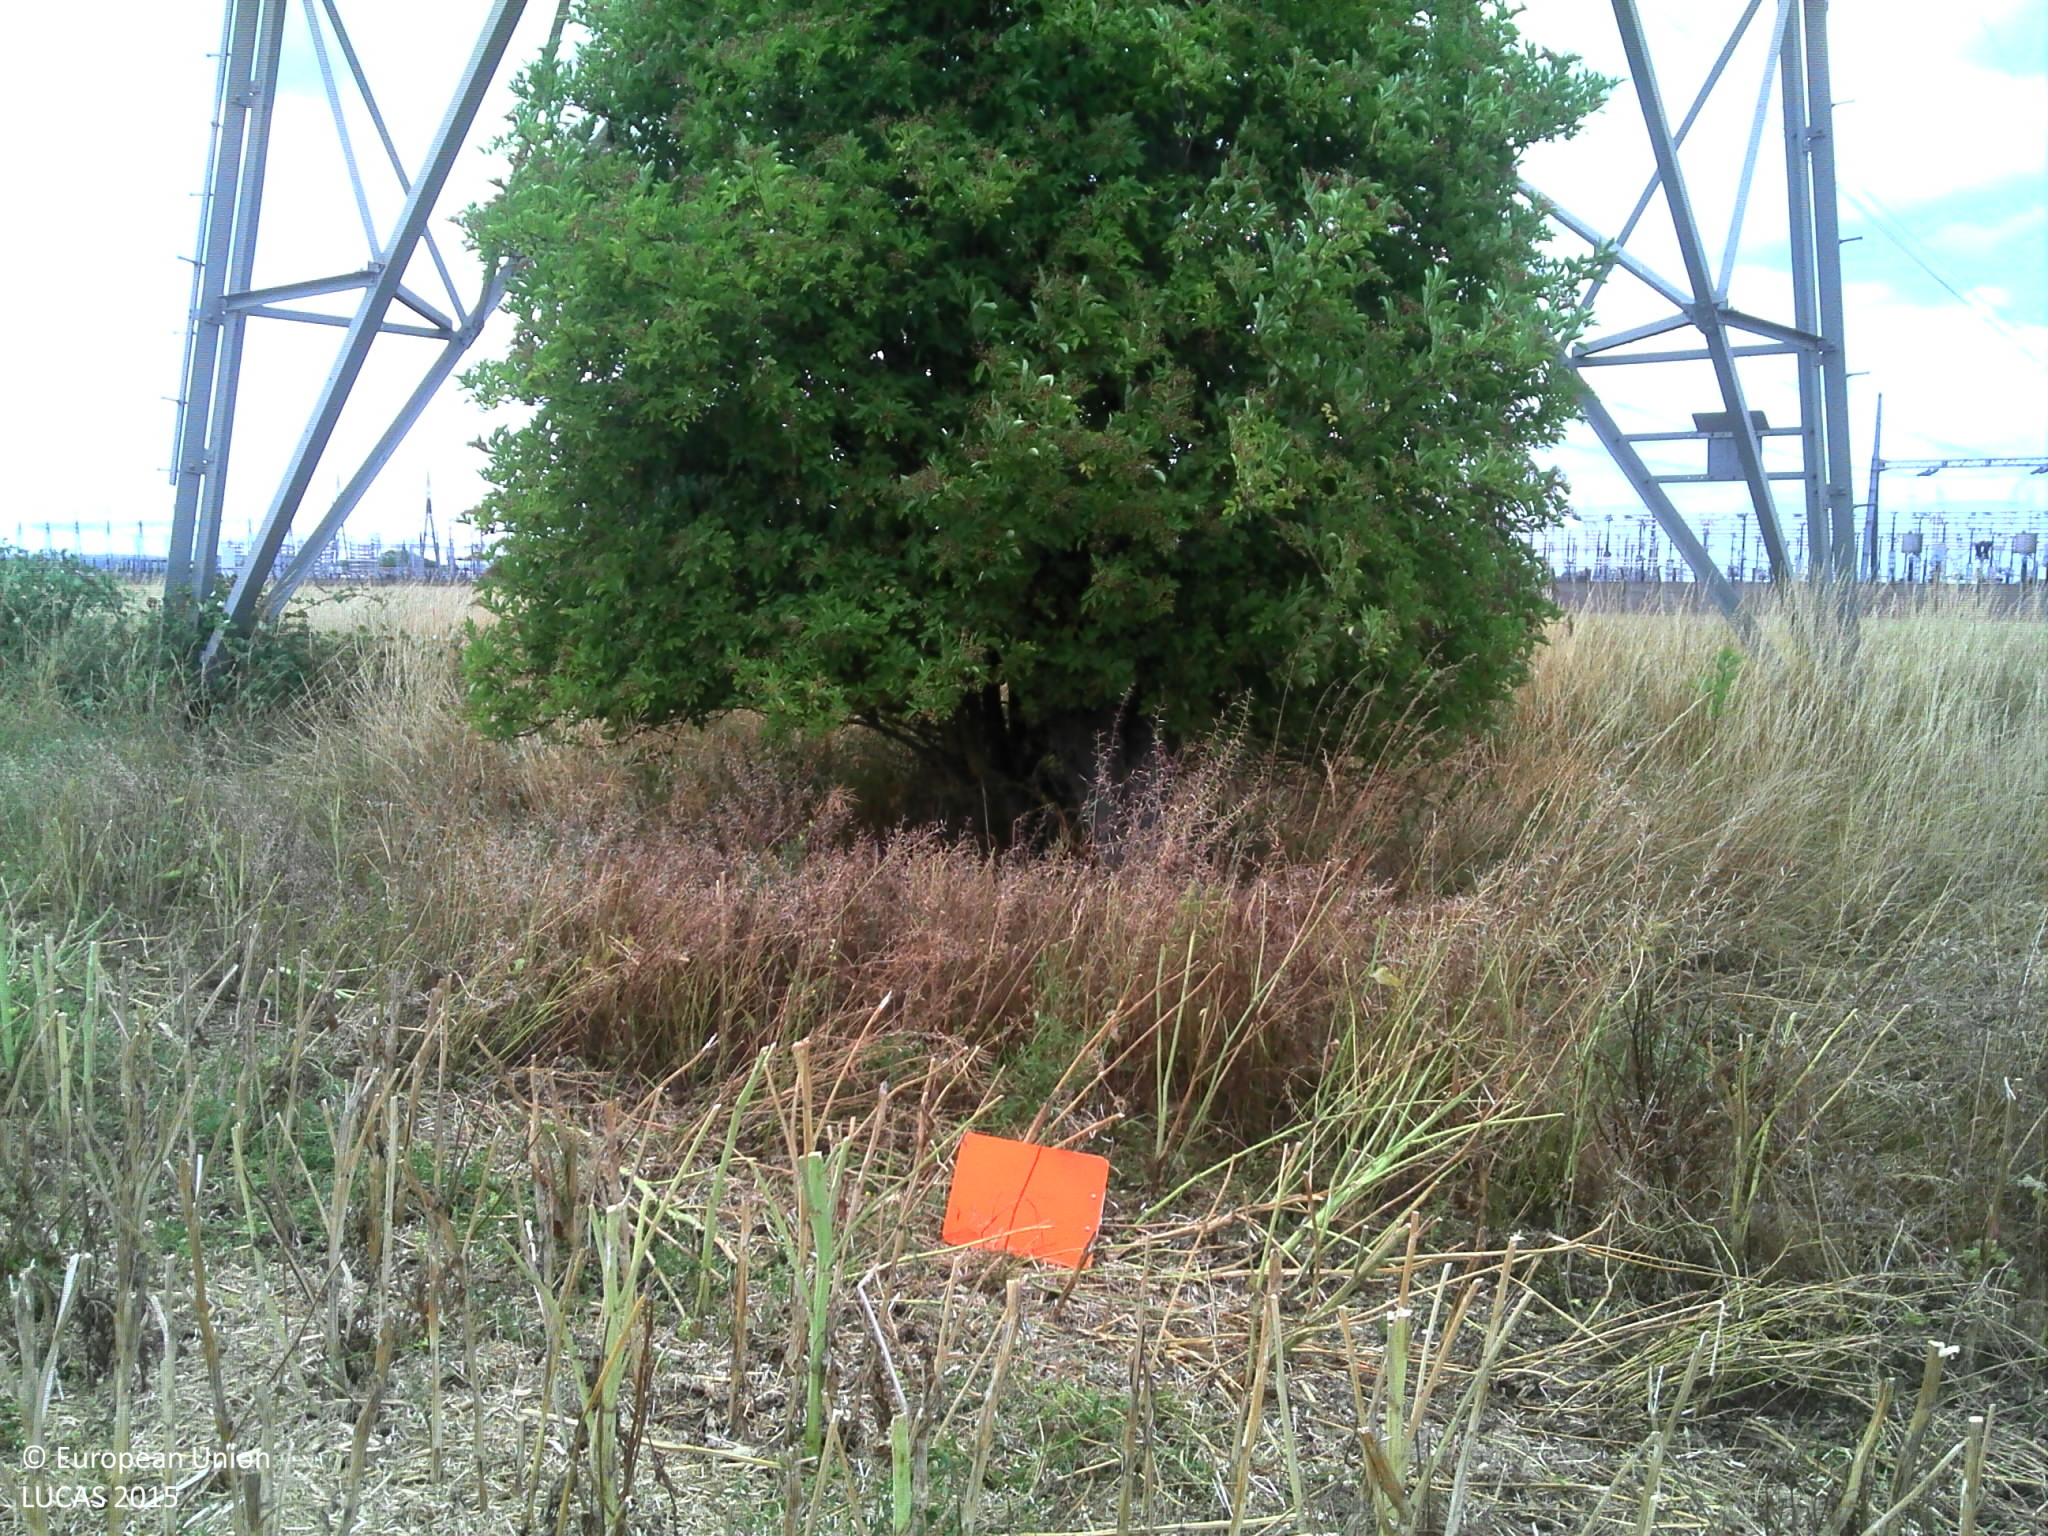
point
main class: Cropland
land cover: Rape and turnip rape
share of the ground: 25 - 50 %
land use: Agriculture (excluding fallow land and kitchen gardens)
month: July
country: FR
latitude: 49.9385
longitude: 2.2532
